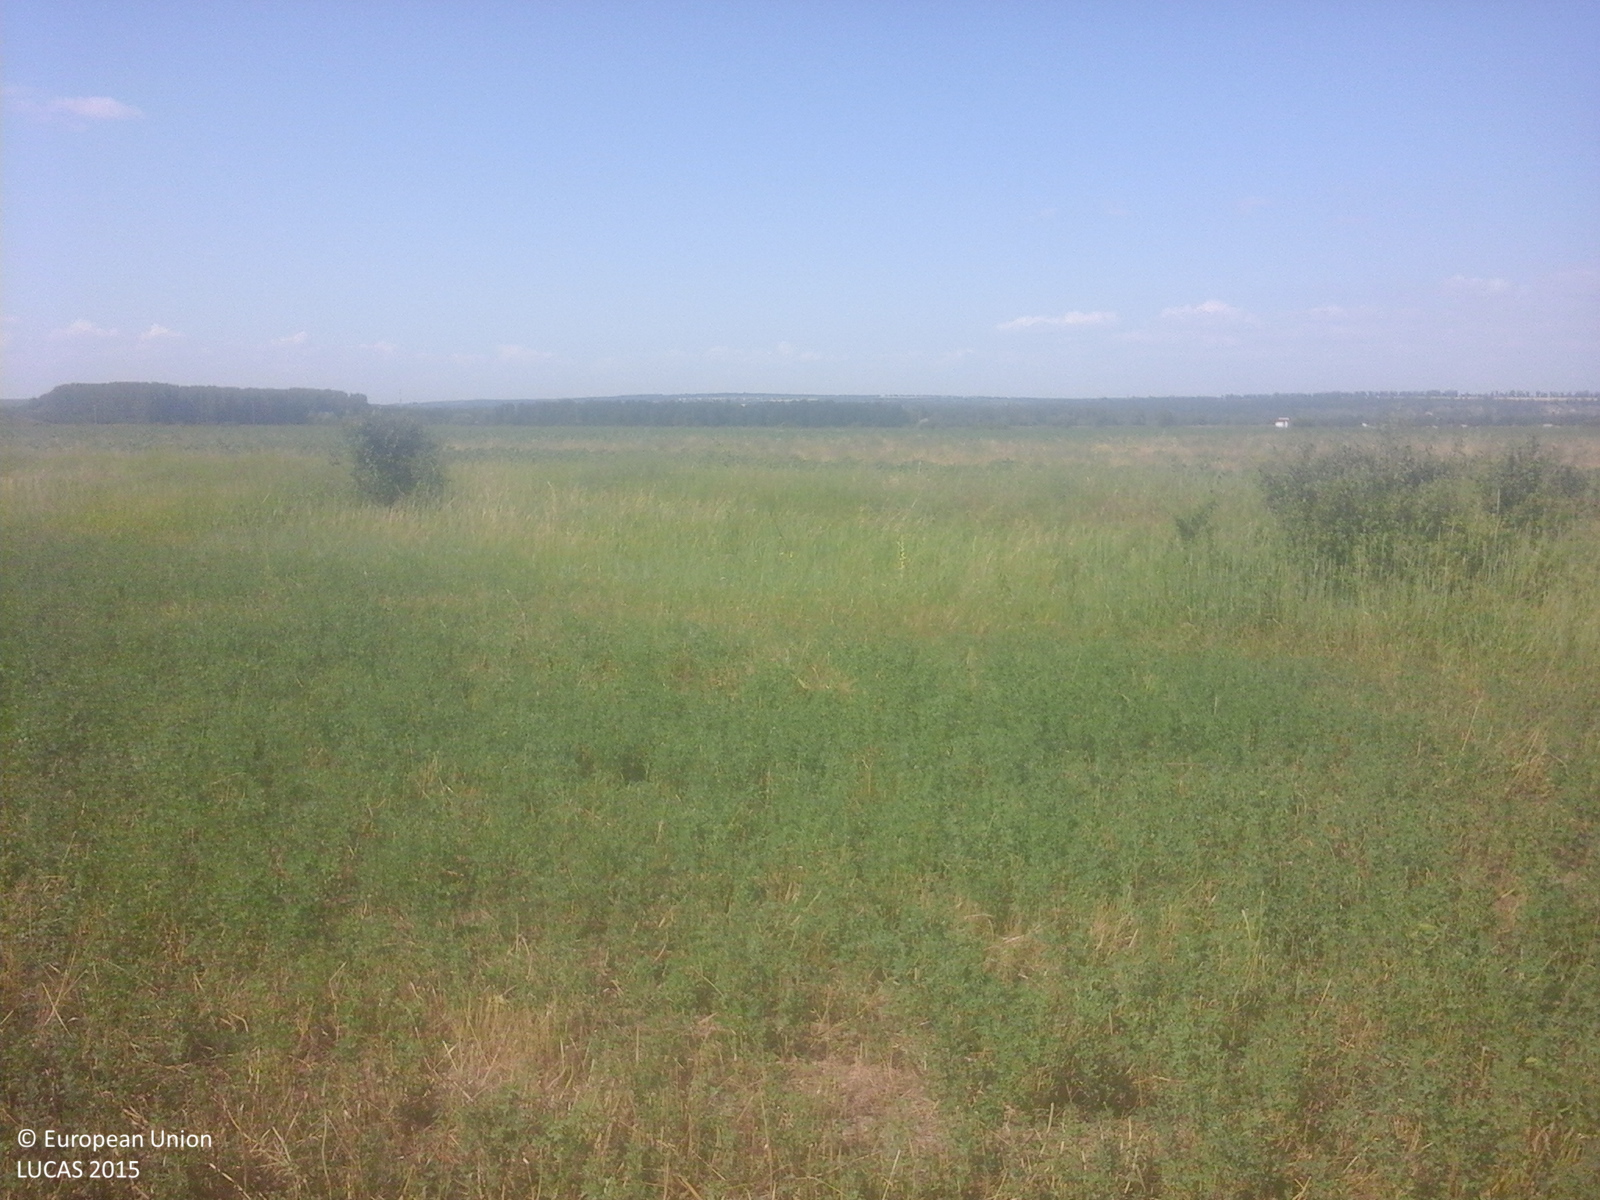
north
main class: Cropland
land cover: Lucerne
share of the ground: > 75 %
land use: Agriculture (excluding fallow land and kitchen gardens)
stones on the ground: < 10 %
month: June
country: RO
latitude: 47.2747
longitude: 27.6905
